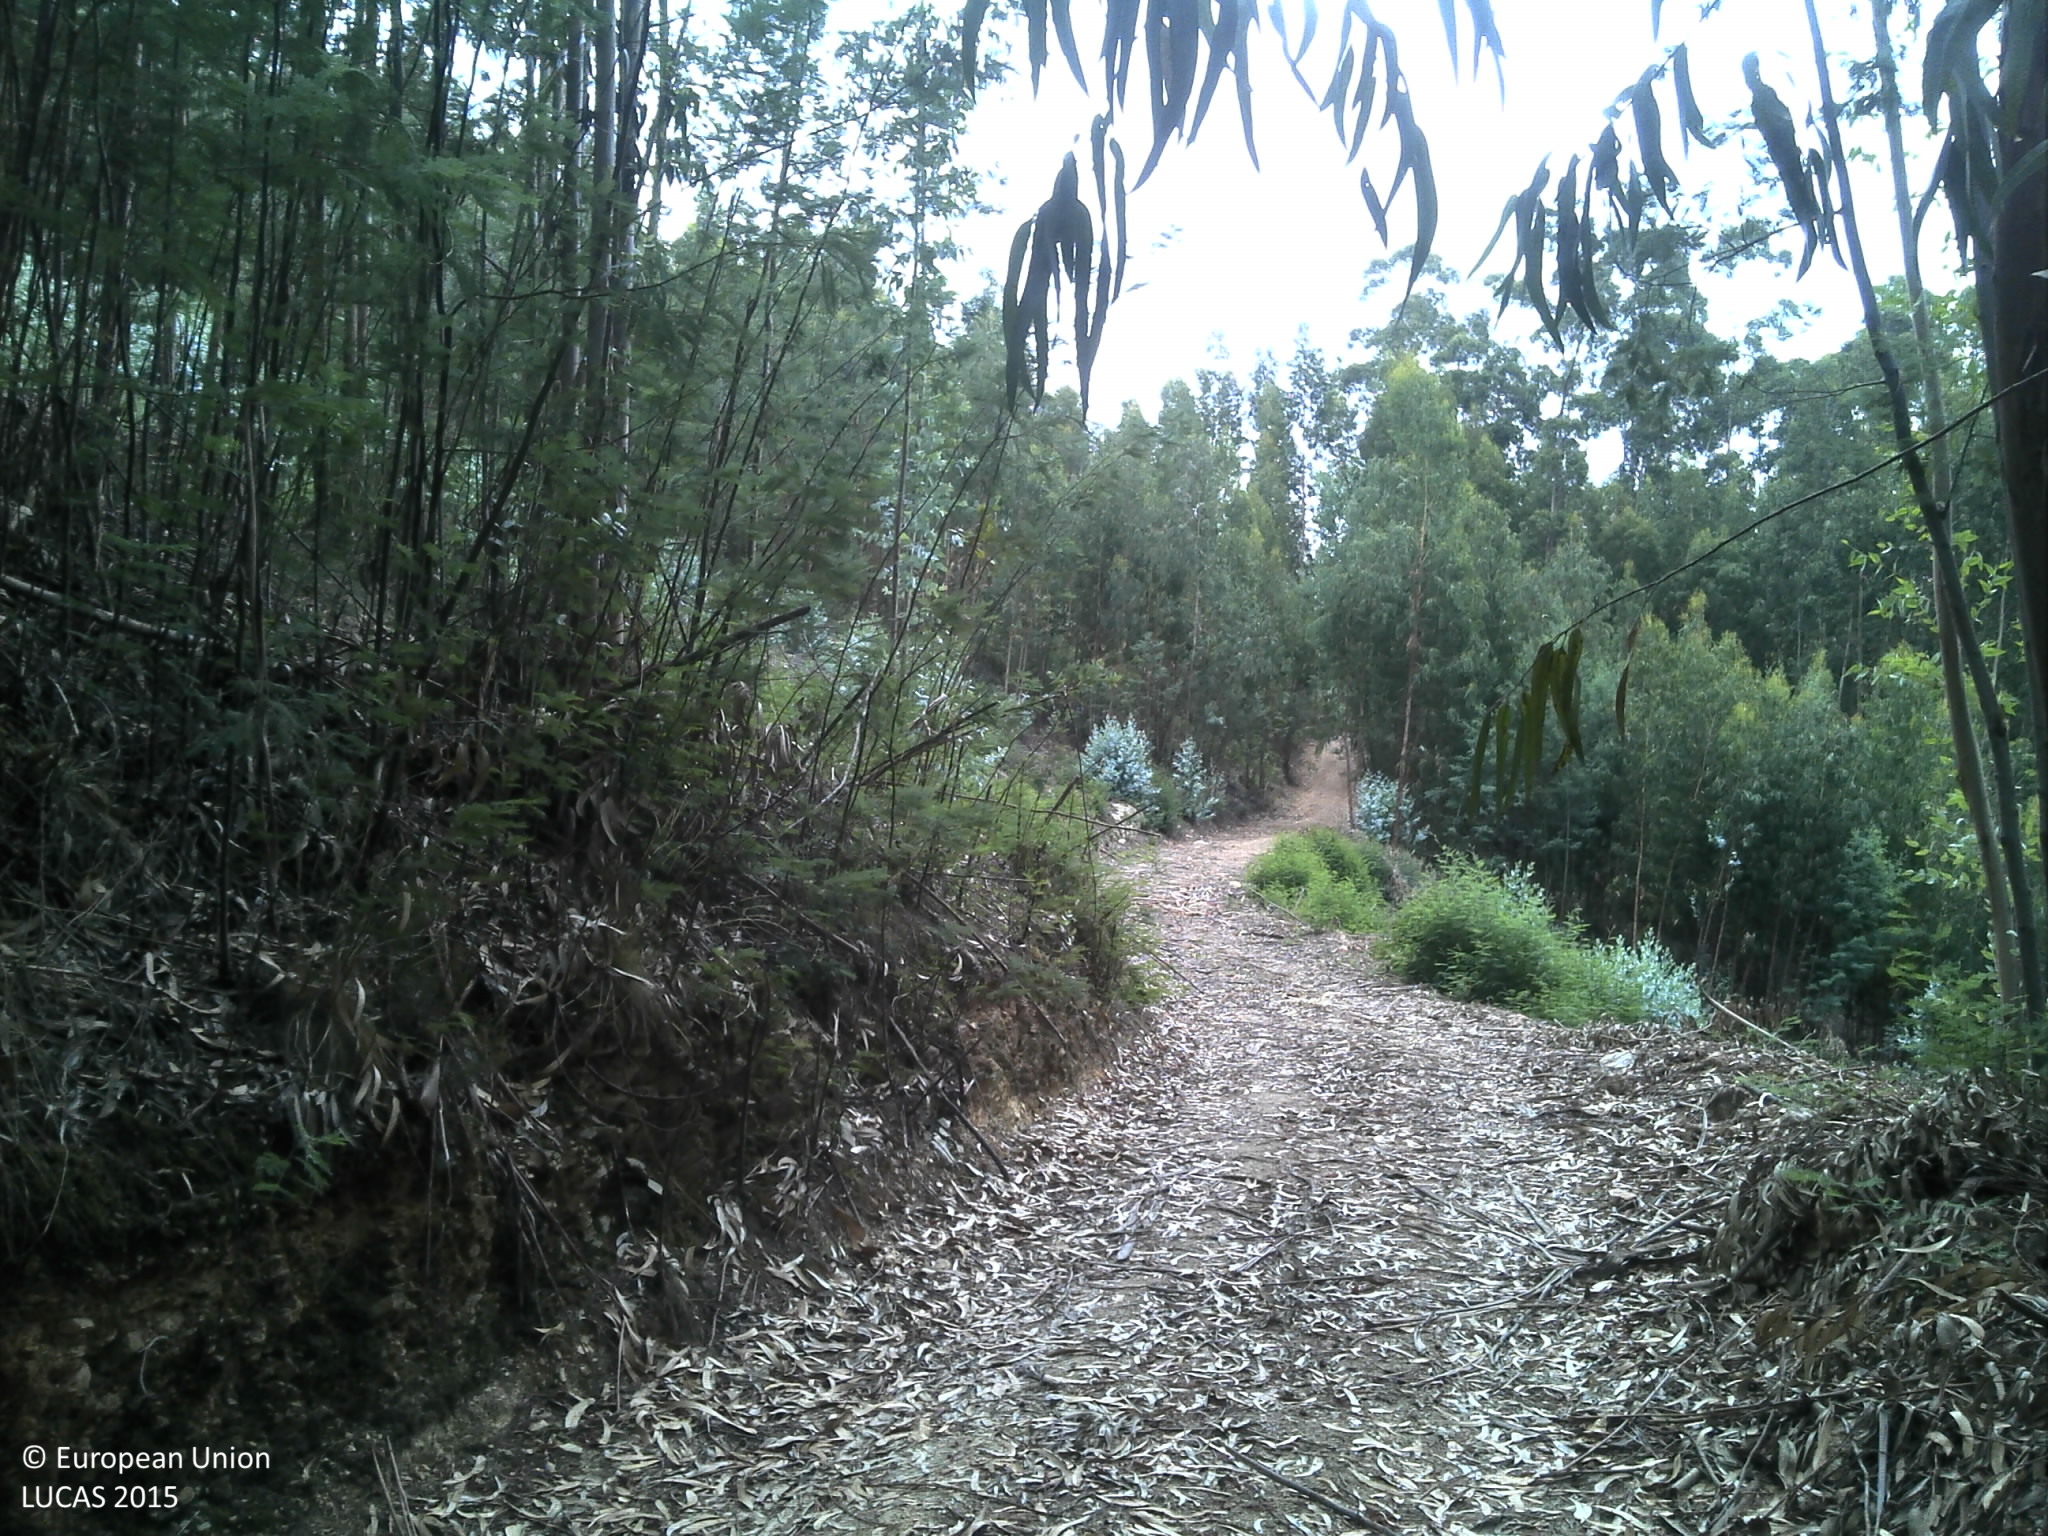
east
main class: Woodland
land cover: Broadleaved woodland
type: exotic forest
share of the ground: 50 - 75 %
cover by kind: broadleaved forest trees 60 %, unconsolidated bare surface 25 %, shrubs 15 %
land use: Forestry
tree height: > 5 m
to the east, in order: Broadleaved woodland; Shrubland without tree cover; Tracks; Shrubland without tree cover; Broadleaved woodland; Tracks; Broadleaved woodland
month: July
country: PT
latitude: 40.2683
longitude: -8.2963
